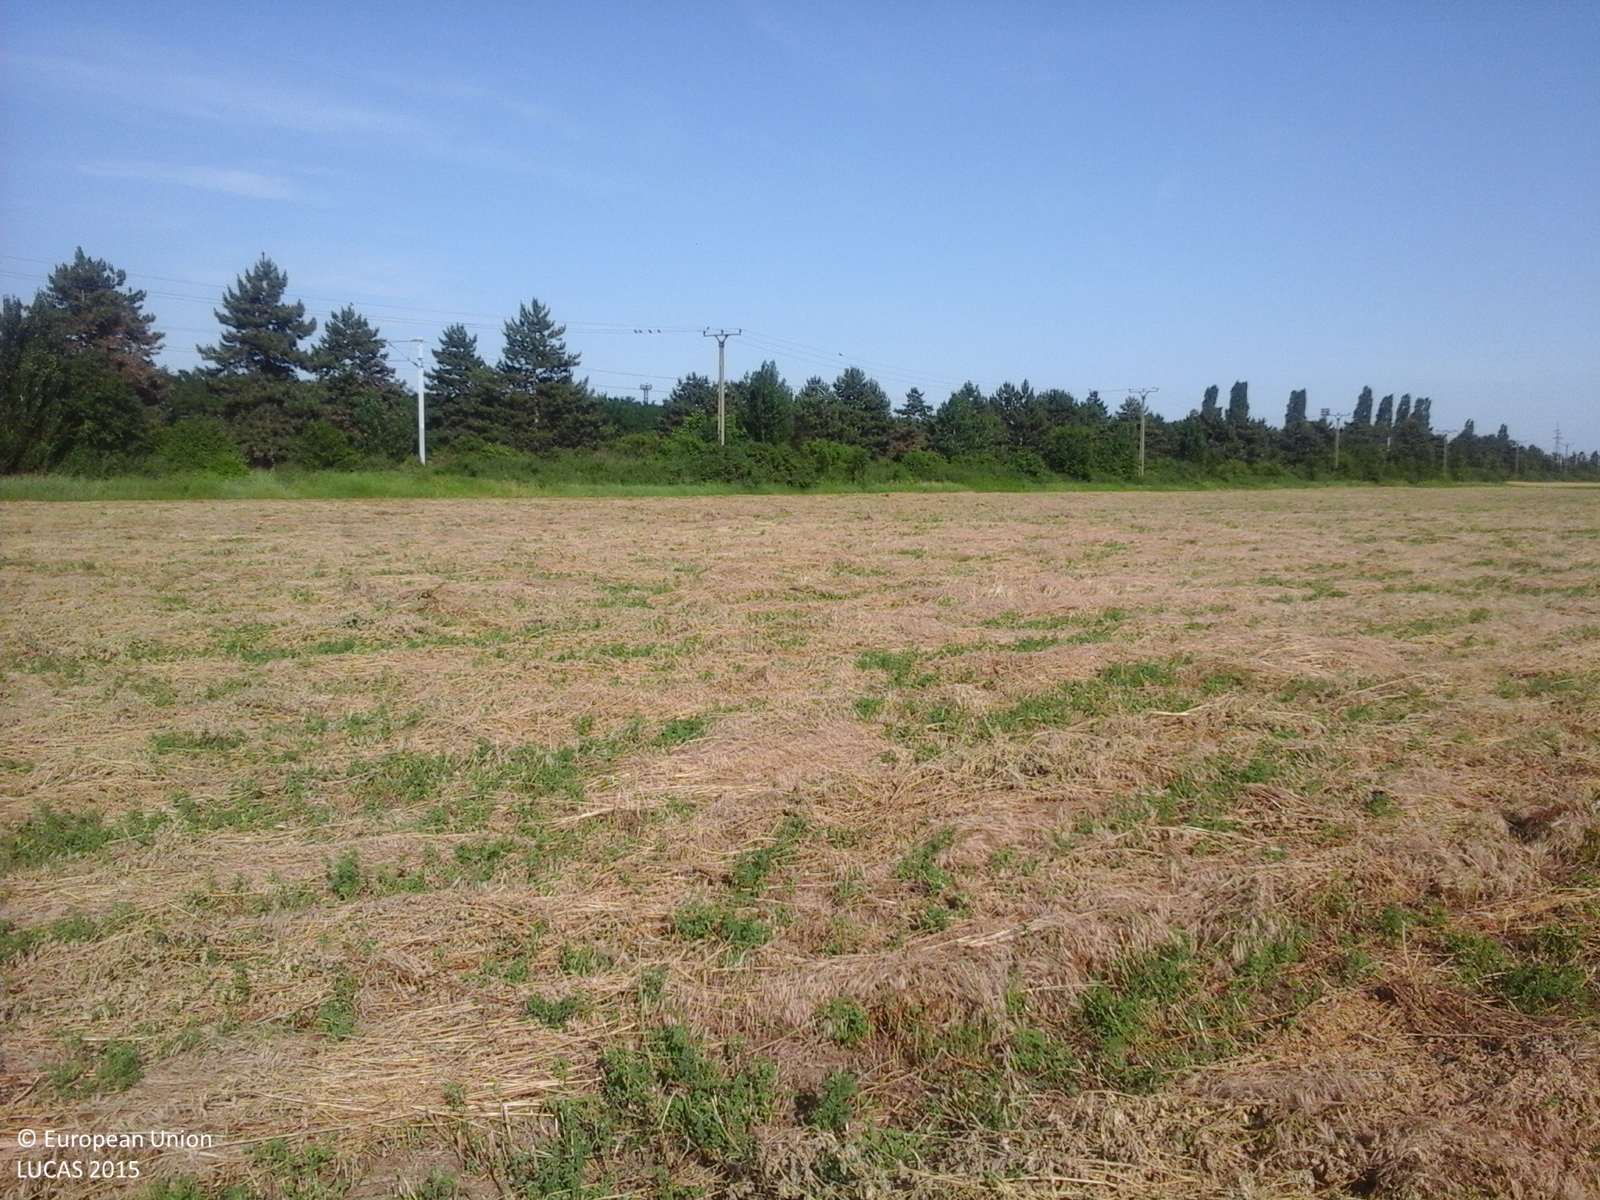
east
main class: Cropland
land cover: Lucerne
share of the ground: > 75 %
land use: Agriculture (excluding fallow land and kitchen gardens)
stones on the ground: < 10 %
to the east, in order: Lucerne; Grass margins; Ditches and canals; Abandoned hedges; Ditches and canals; Abandoned hedges; Tracks; Grassland with sparse tree/shrub cover; Railways; Shrubland with sparse tree cover; Railways; Broadleaved woodland; Ditches and canals; Broadleaved woodland
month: June
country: RO
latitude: 44.9159
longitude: 26.0050
